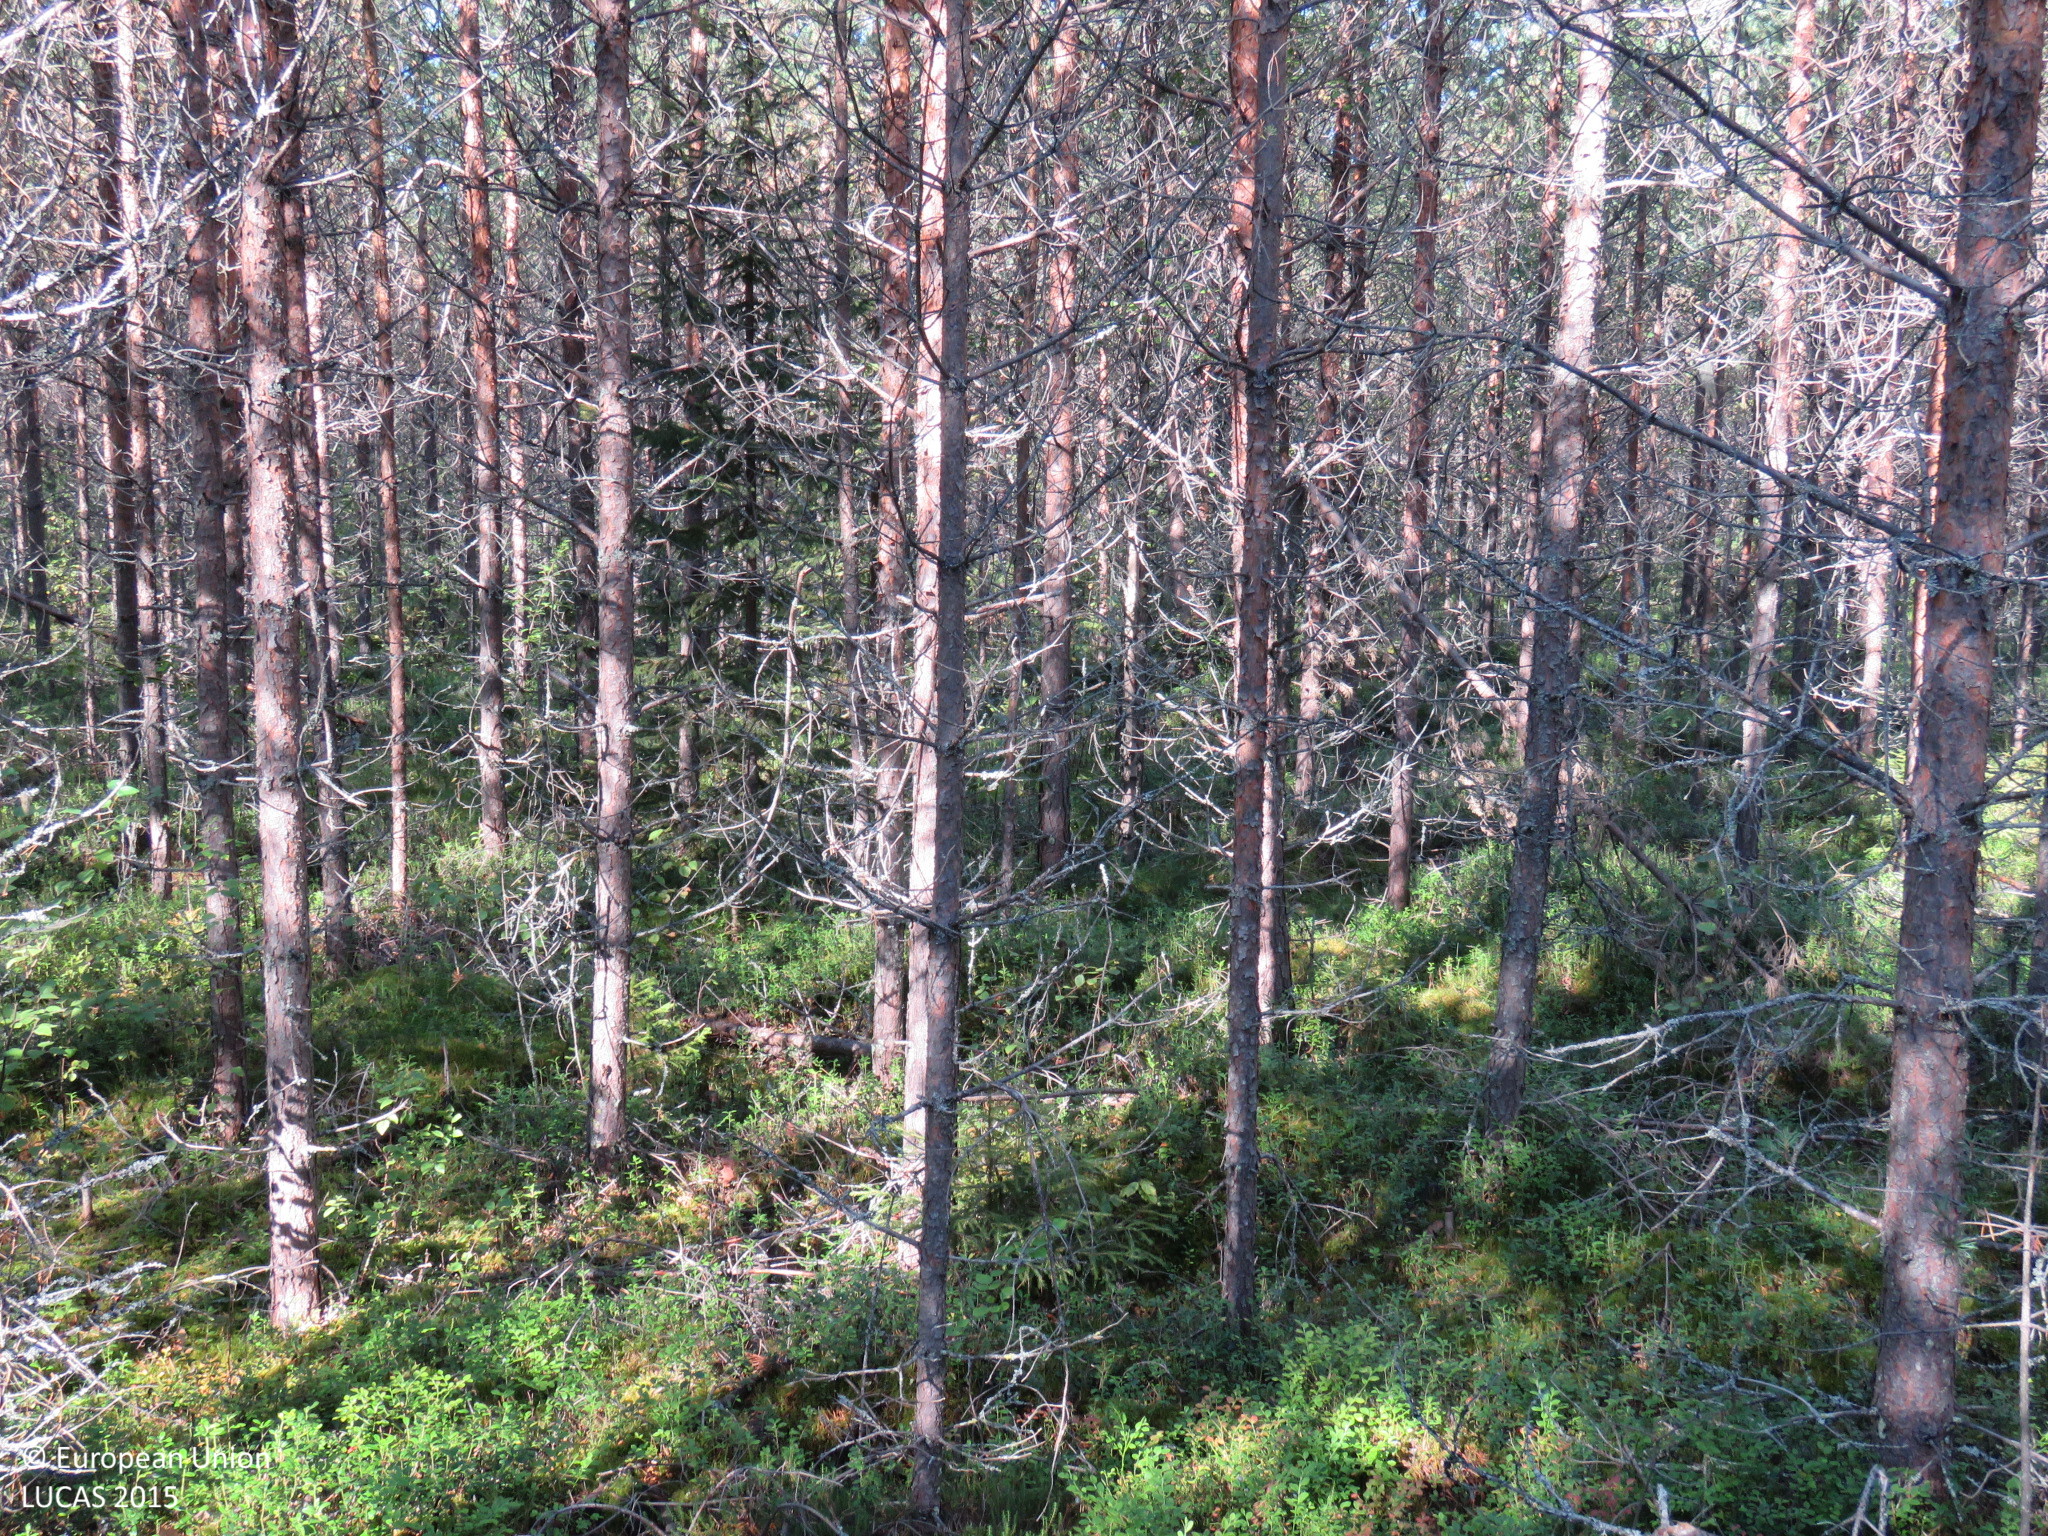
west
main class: Woodland
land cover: Pine dominated coniferous woodland
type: boreal forest
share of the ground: > 75 %
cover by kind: coniferous forest trees 85 %, broadleaved forest trees 5 %, shrubs 5 %, lichens and mosses 5 %
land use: Forestry
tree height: > 5 m
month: August
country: FI
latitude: 65.1560
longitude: 25.5916
